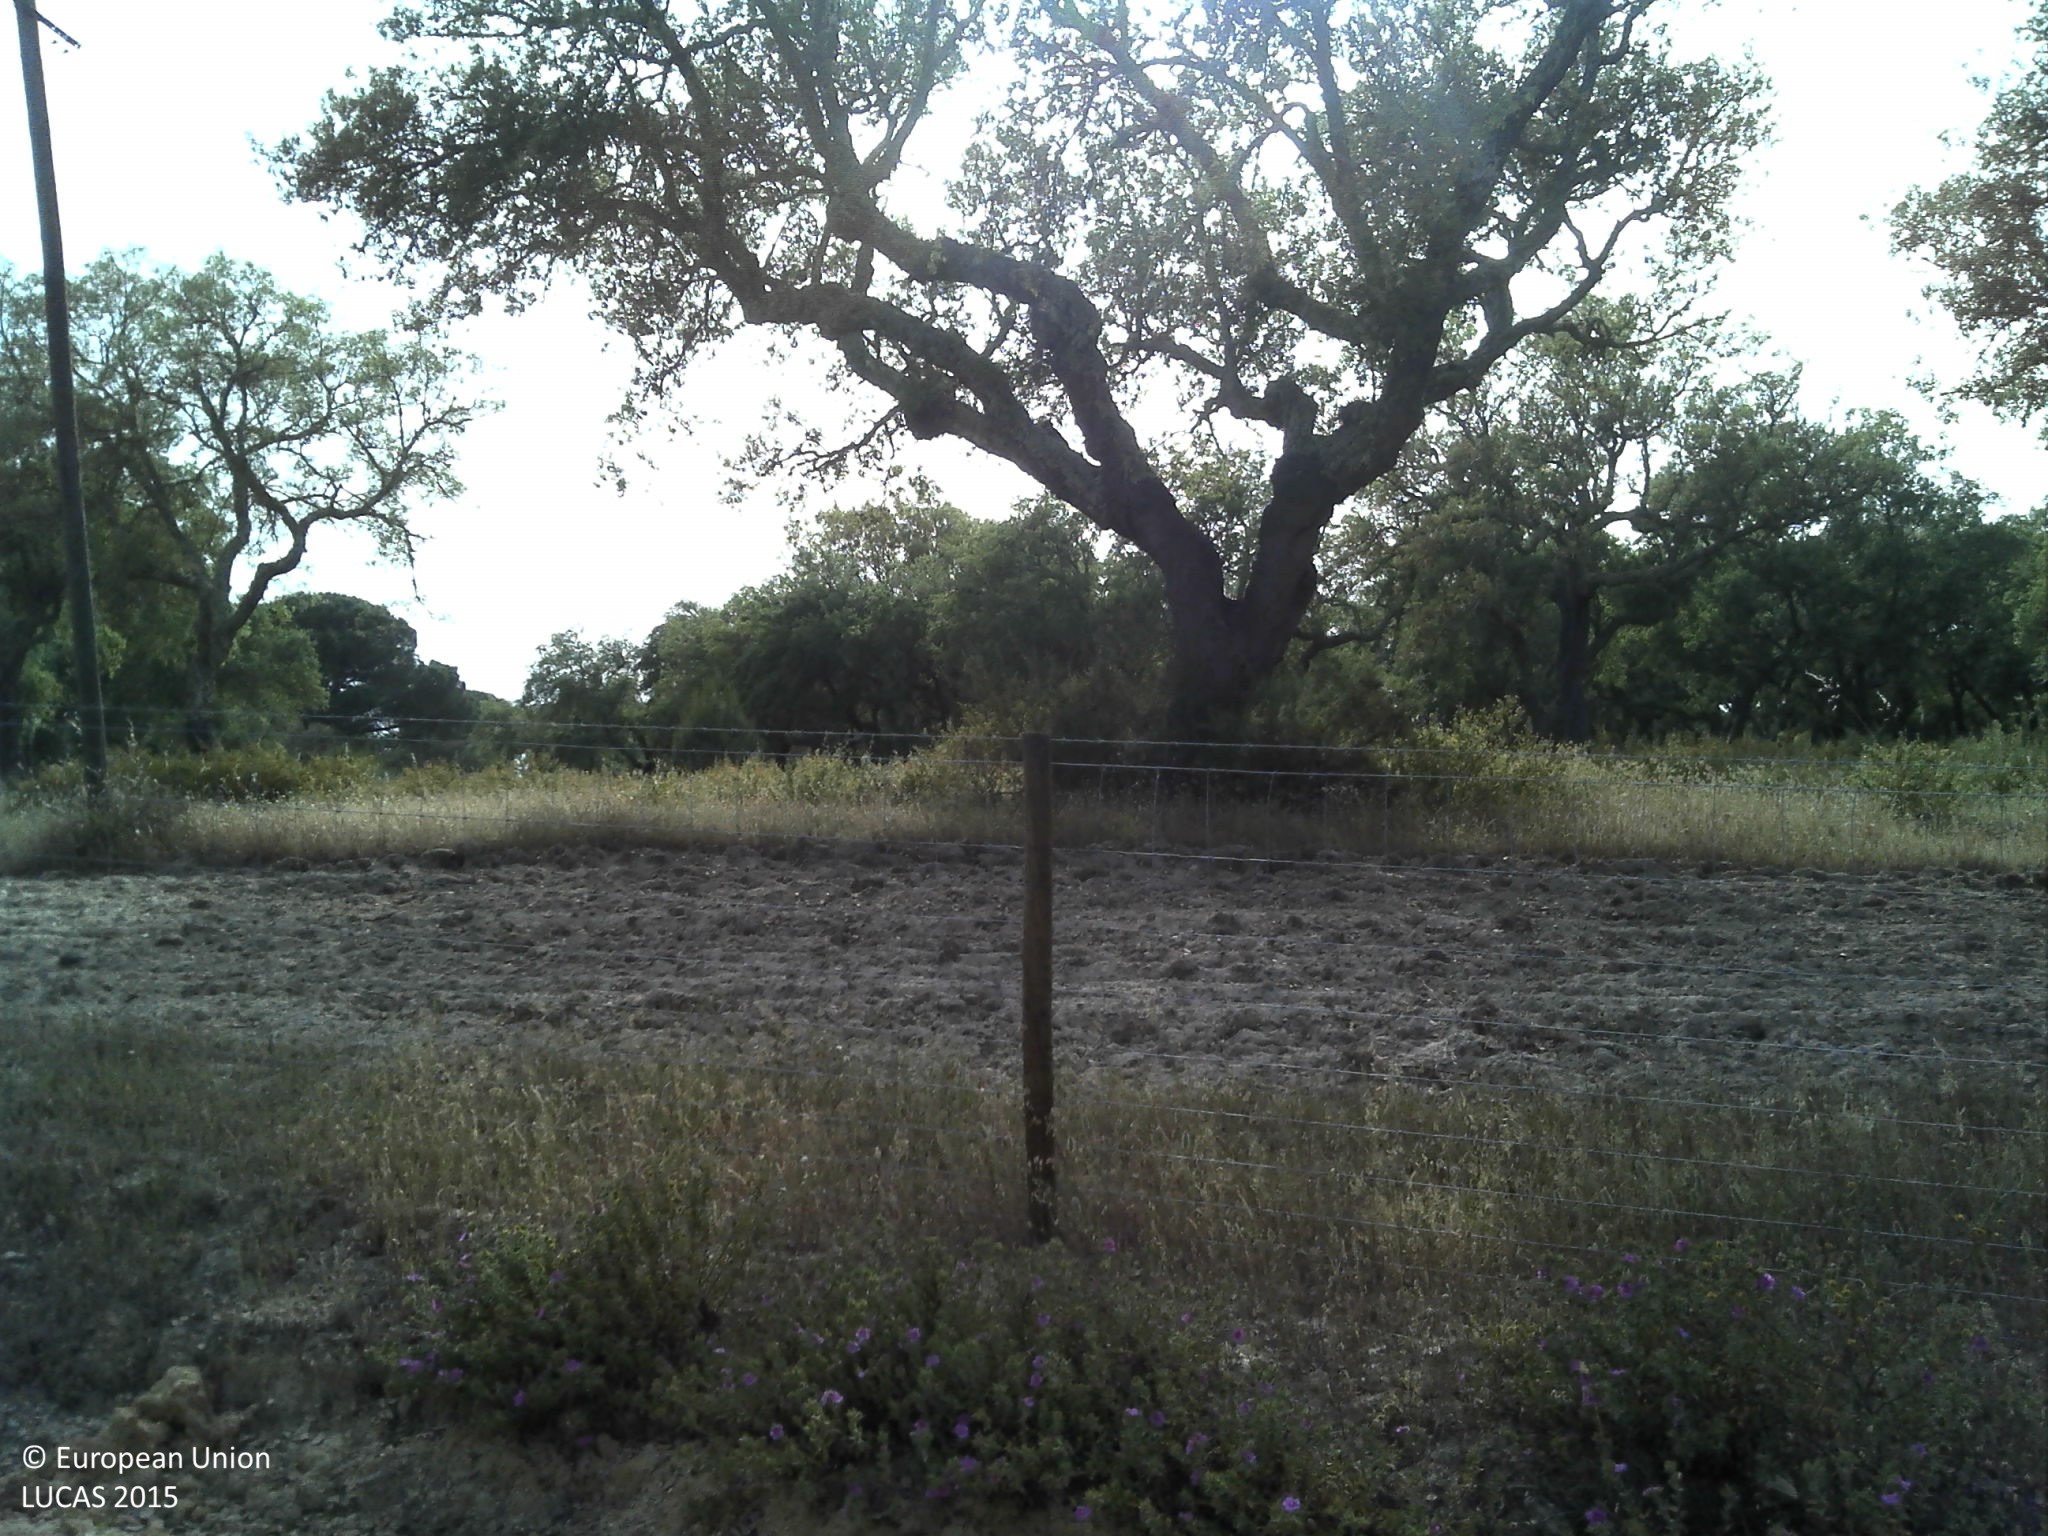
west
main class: Woodland
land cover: Broadleaved woodland
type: broadleaved evergreen forest
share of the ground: 50 - 75 %
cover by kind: broadleaved forest trees 55 %, unconsolidated bare surface 25 %, herbaceous plants 20 %
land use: Forestry
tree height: > 5 m
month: May
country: PT
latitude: 38.3062
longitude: -8.4010
